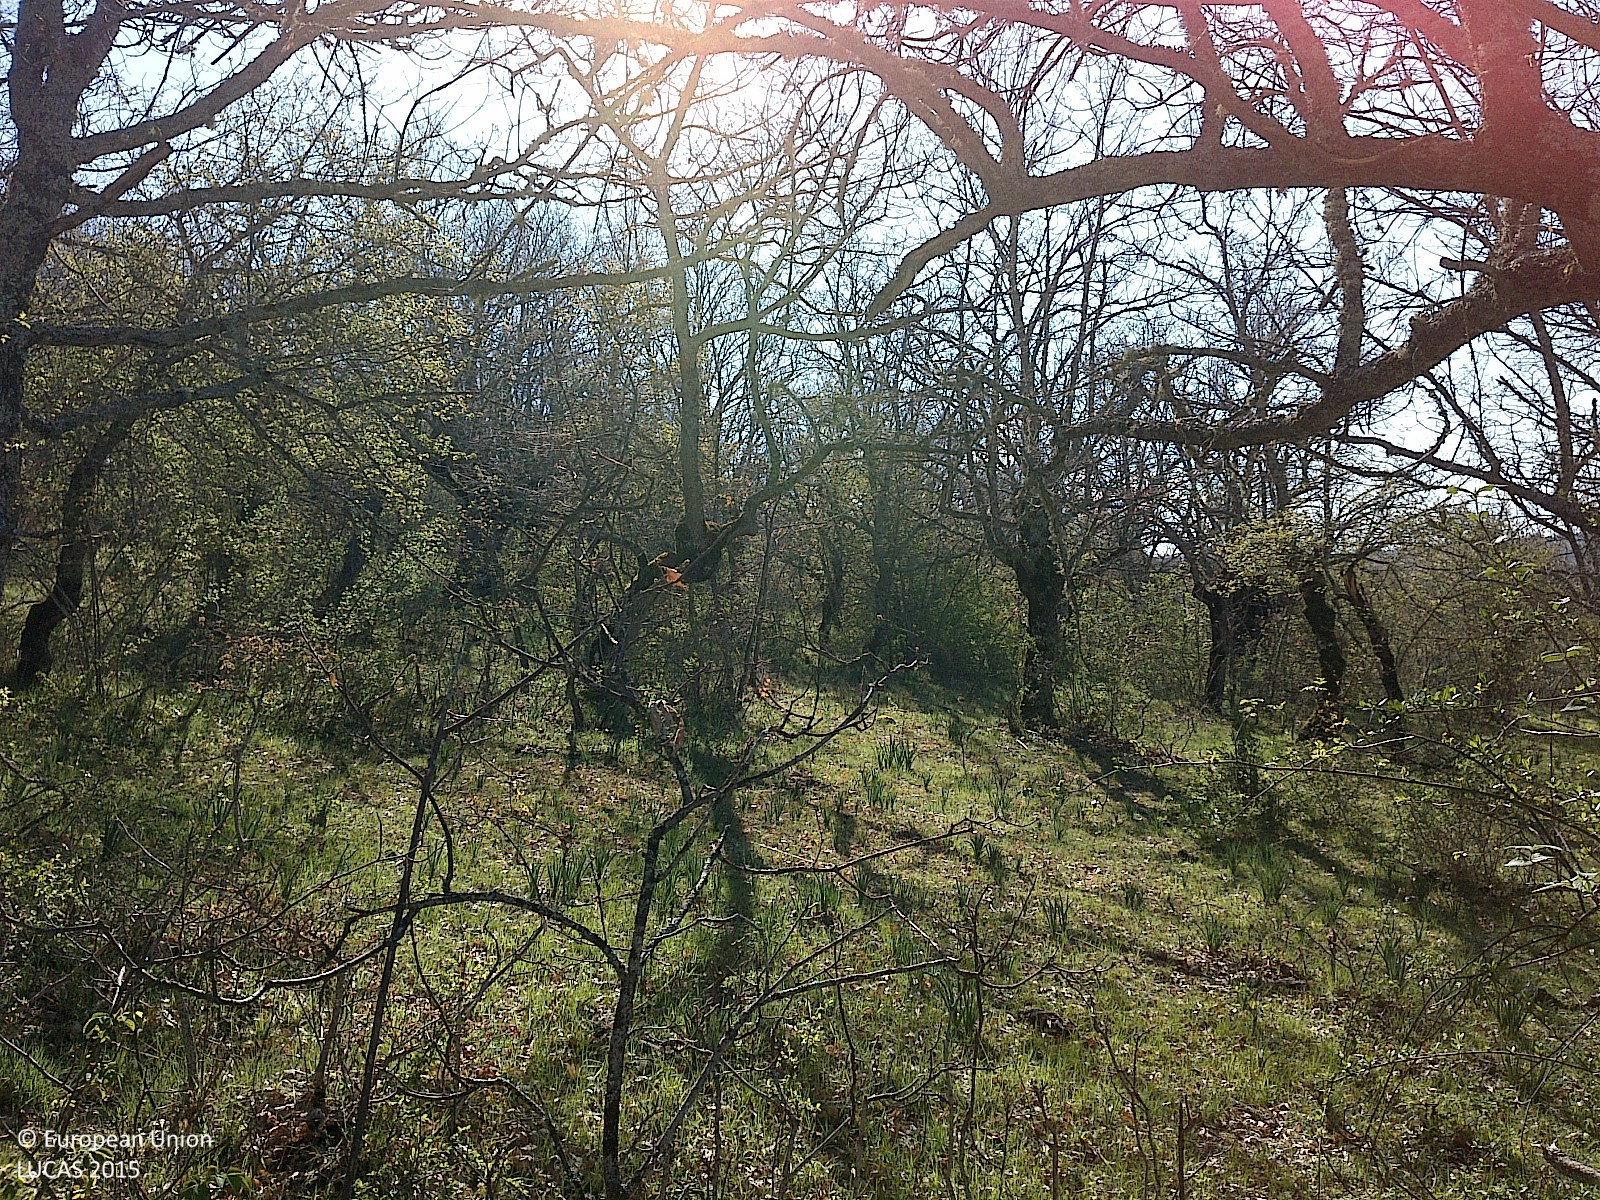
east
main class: Woodland
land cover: Broadleaved woodland
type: thermophilous deciduous forest
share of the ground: 25 - 50 %
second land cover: Grassland without tree/shrub cover
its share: > 75 %
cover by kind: herbaceous plants 55 %, broadleaved forest trees 35 %, shrubs 10 %
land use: Forestry
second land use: Agriculture (excluding fallow land and kitchen gardens)
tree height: > 5 m
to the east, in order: Broadleaved woodland; Grassland without tree/shrub cover
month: April
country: ES
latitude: 42.1494
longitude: -3.3525
